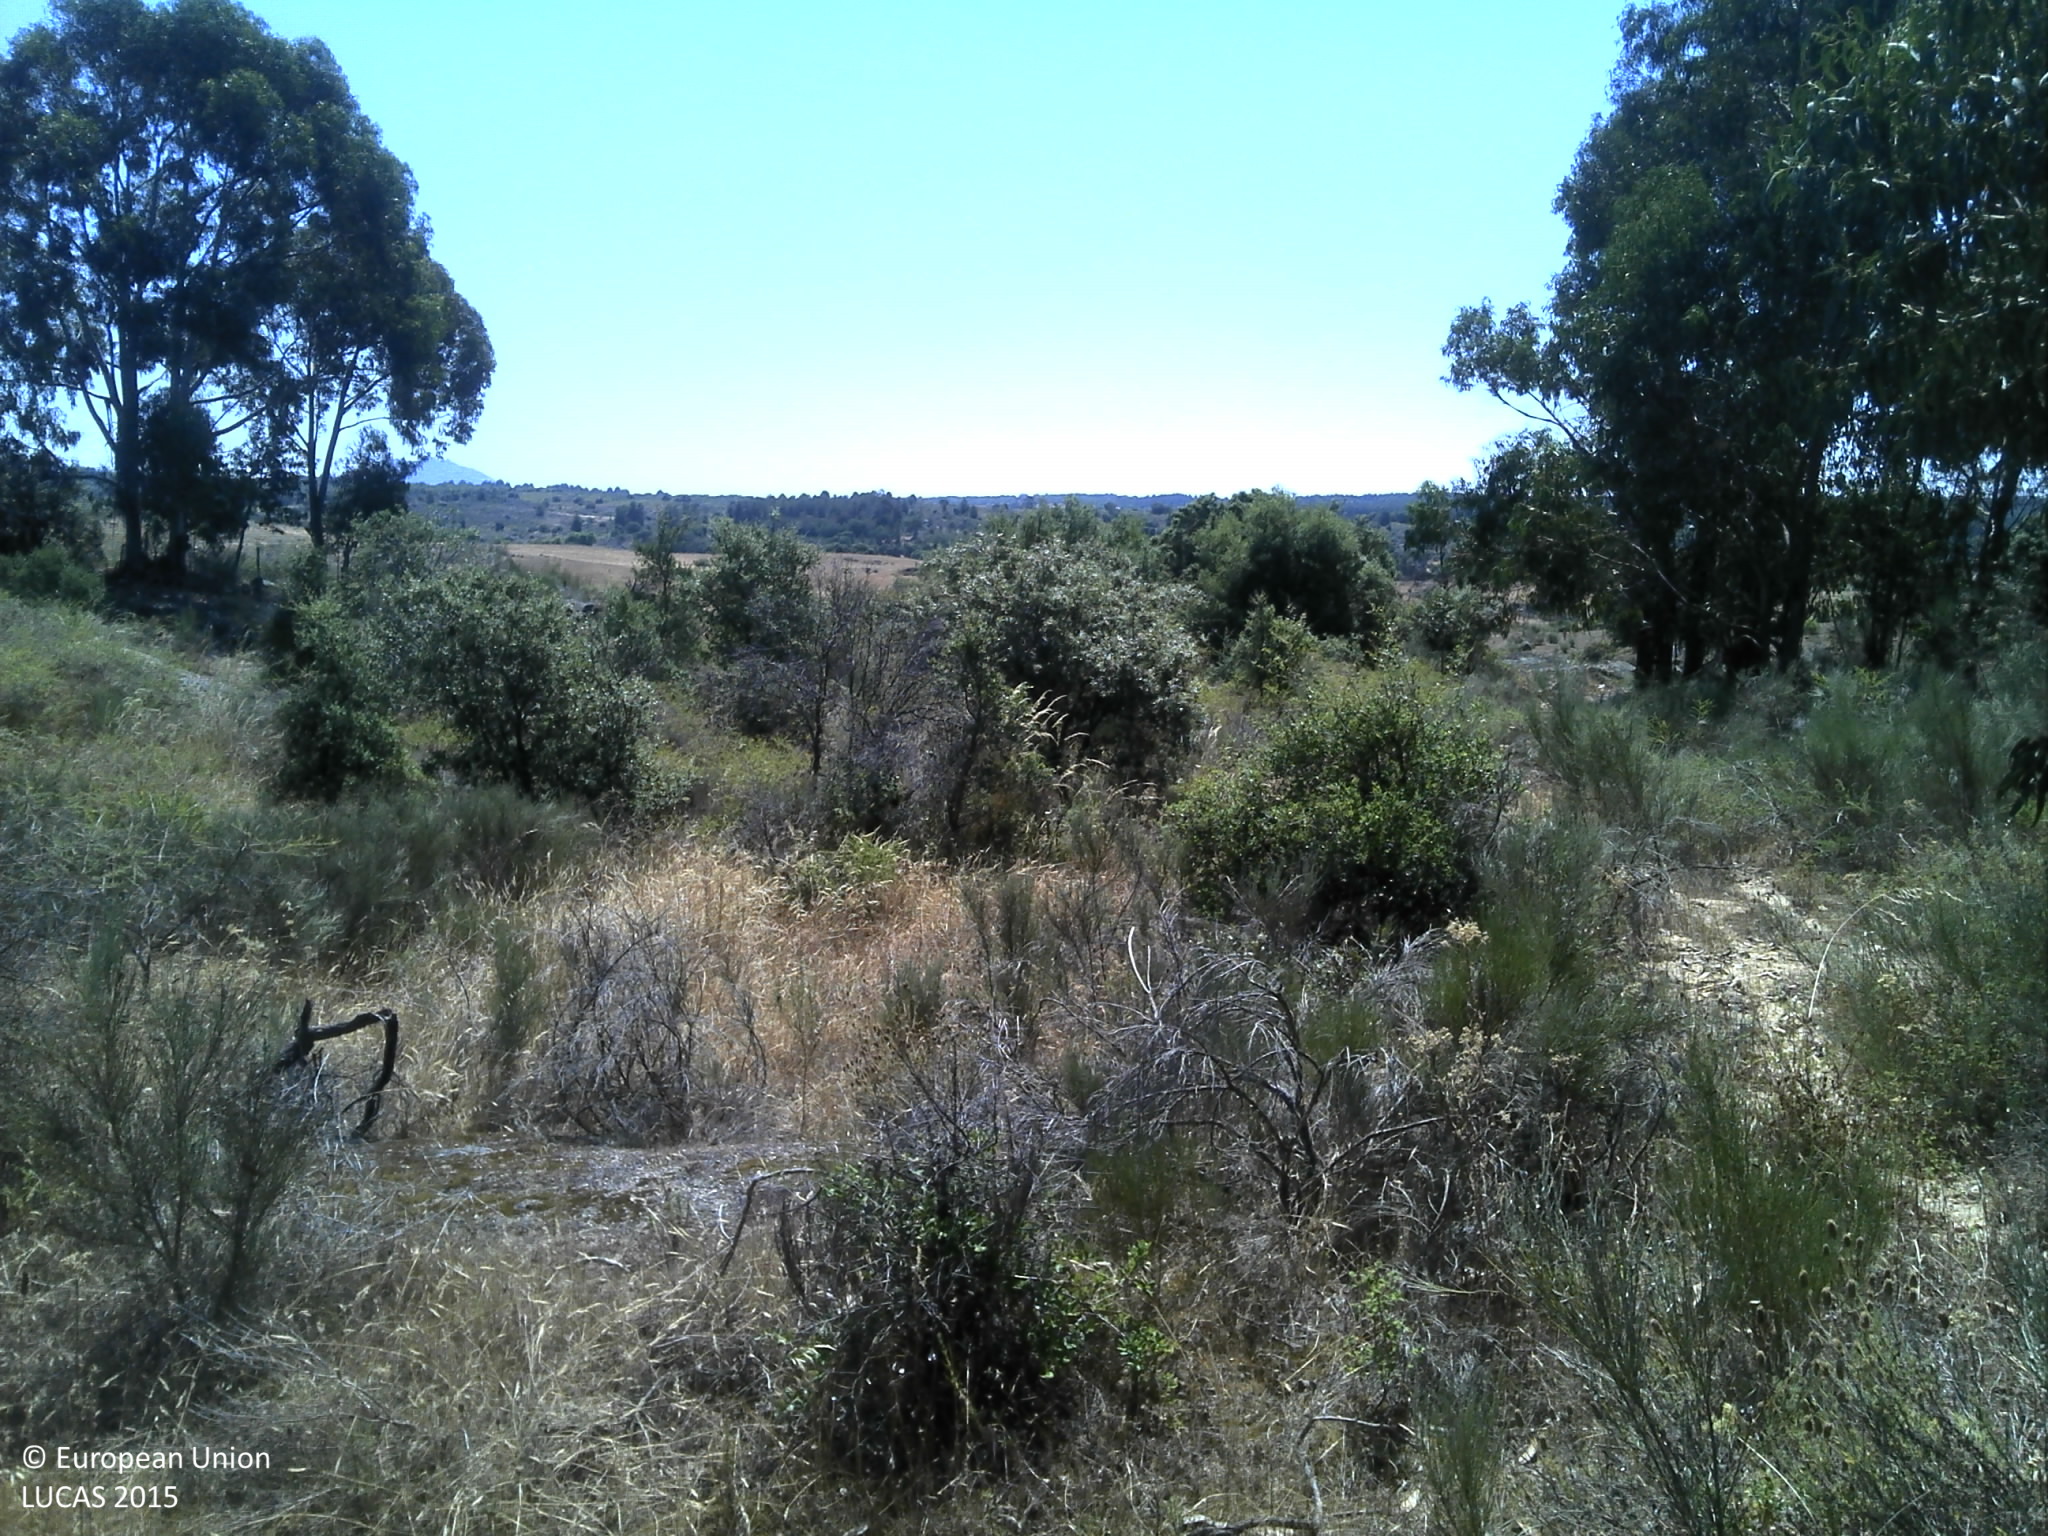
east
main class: Woodland
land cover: Broadleaved woodland
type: exotic forest
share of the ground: 25 - 50 %
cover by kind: broadleaved forest trees 50 %, shrubs 20 %, unconsolidated bare surface 15 %, herbaceous plants 10 %
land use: Forestry
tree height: > 5 m
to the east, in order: Broadleaved woodland; Shrubland with sparse tree cover; Dry stone walls; Fences; Tracks; Fences; Grassland with sparse tree/shrub cover; Grassland without tree/shrub cover
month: June
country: PT
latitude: 40.0469
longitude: -7.2933
